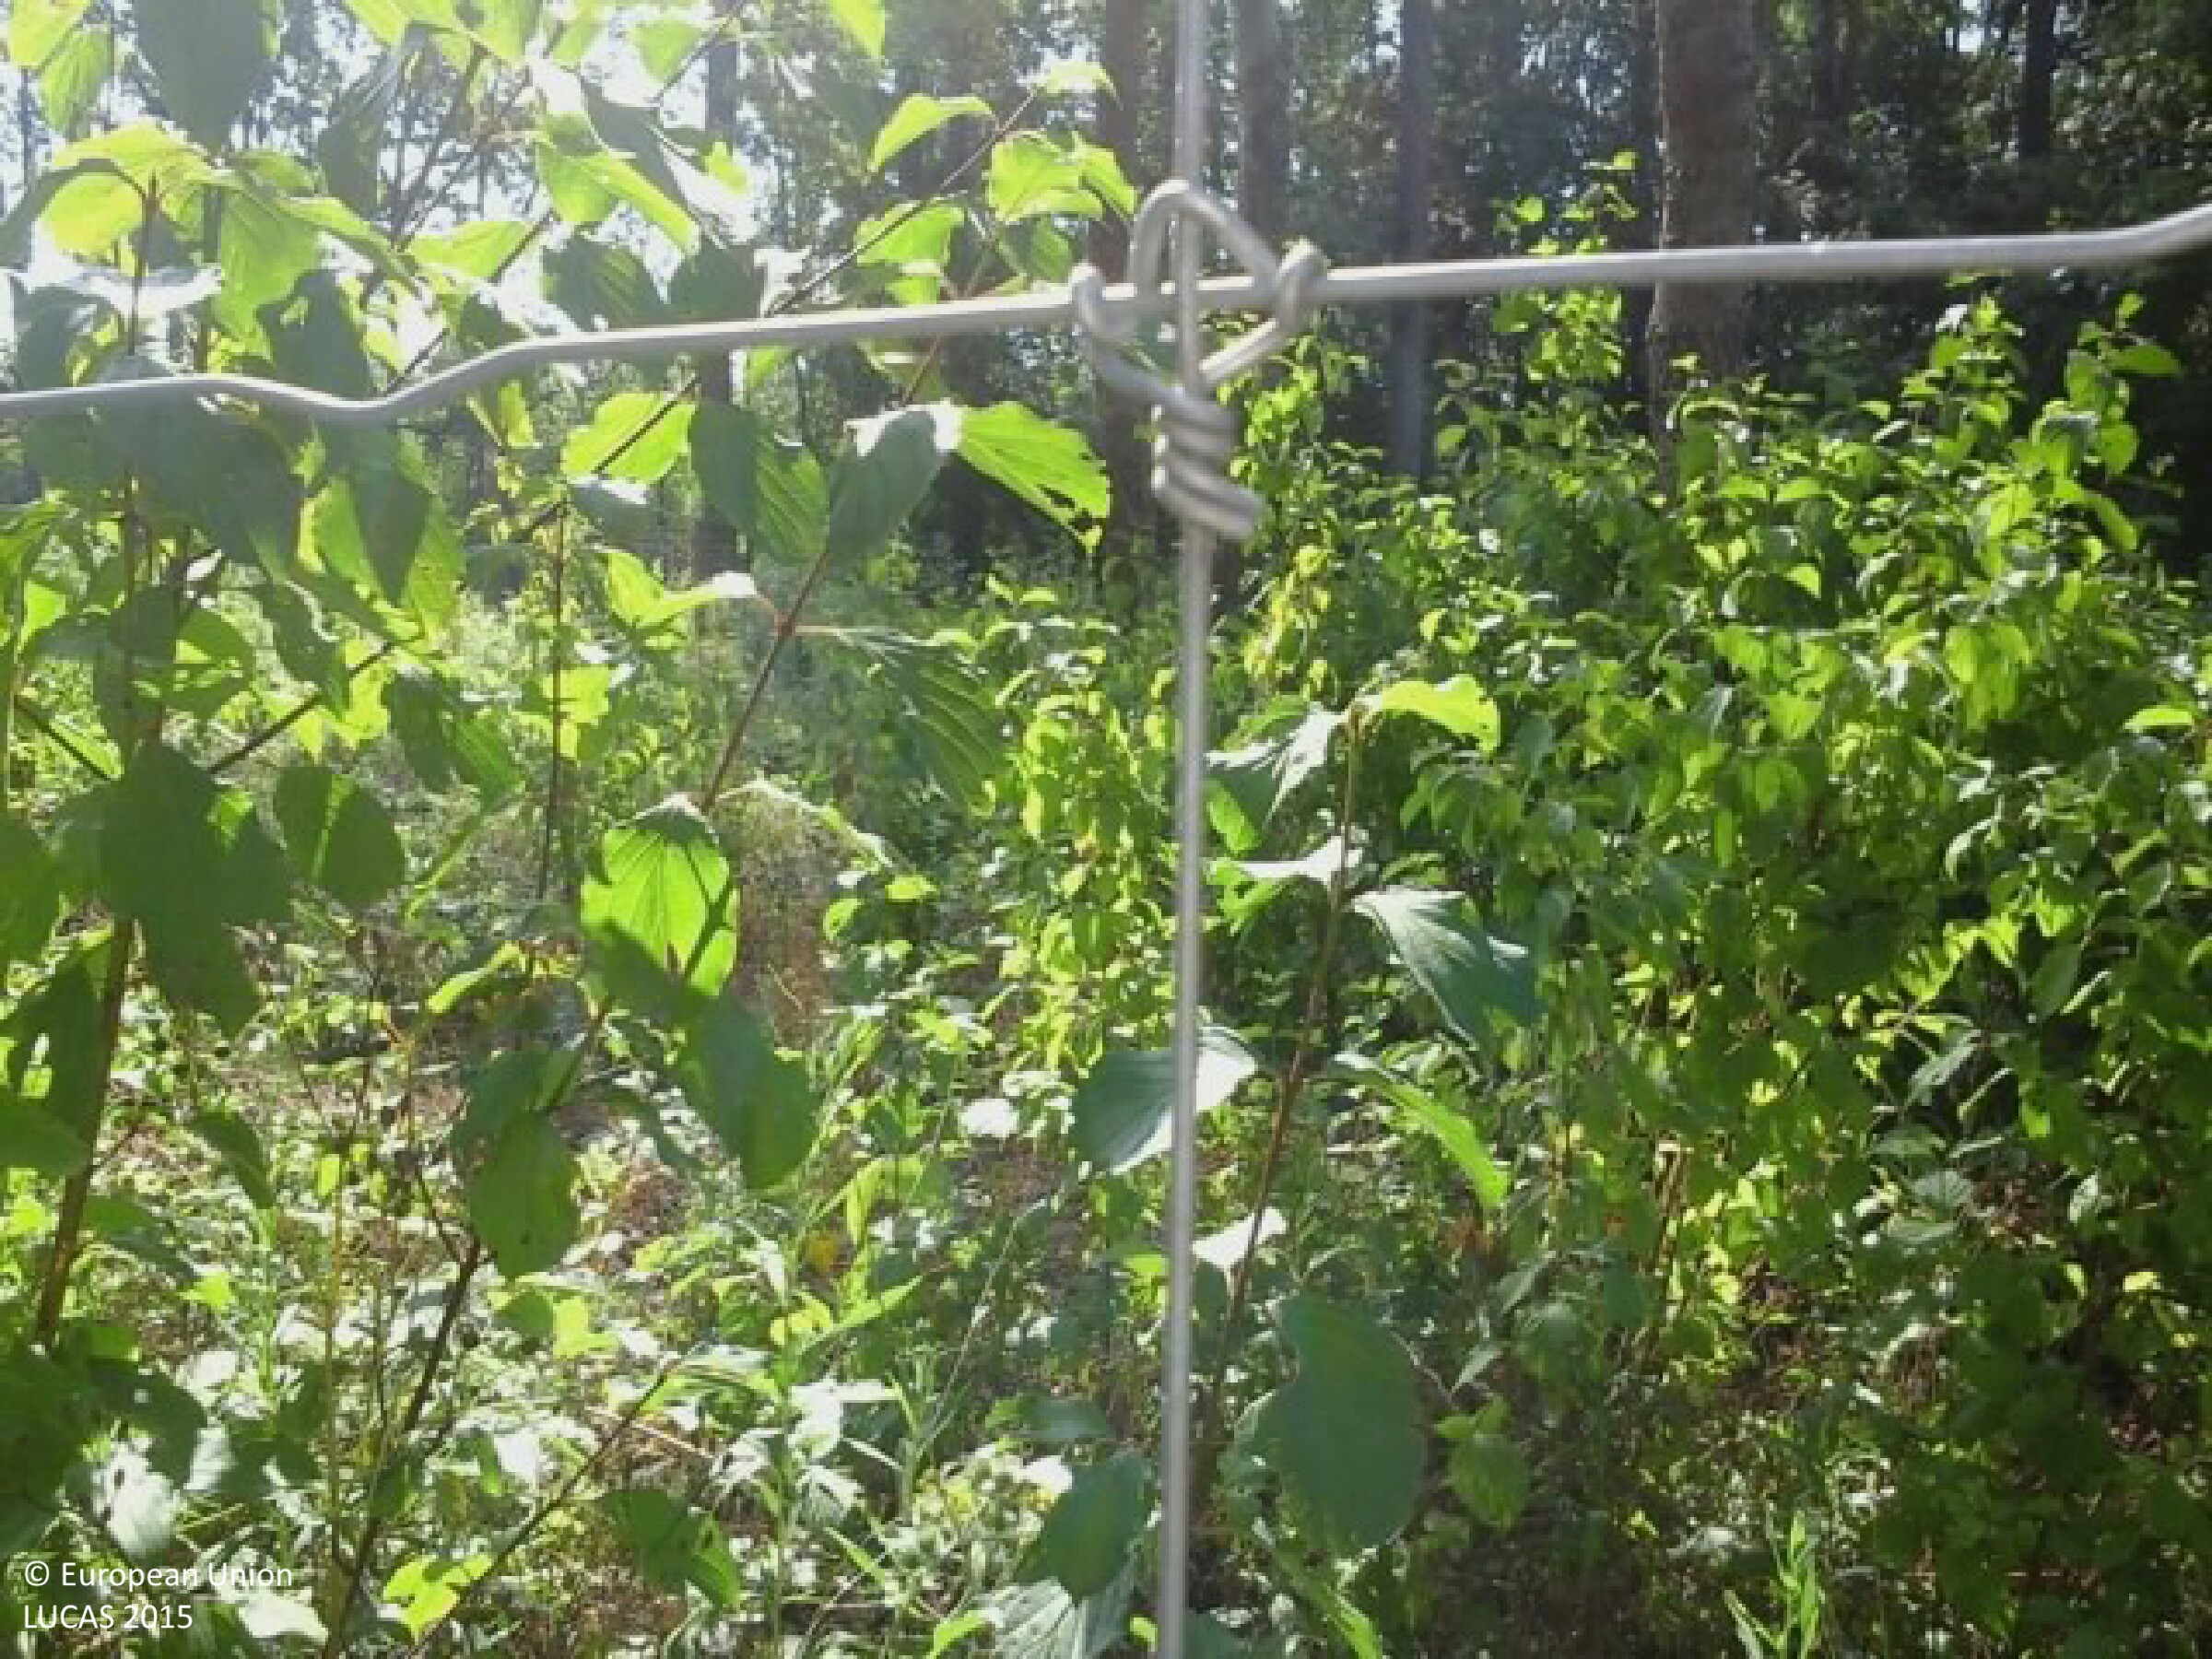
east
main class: Woodland
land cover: Broadleaved woodland
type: mesophytic deciduous forest
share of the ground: 25 - 50 %
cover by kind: broadleaved forest trees 60 %, herbaceous plants 25 %, shrubs 15 %
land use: Forestry
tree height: < 5 m
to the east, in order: Broadleaved woodland; Fences; Broadleaved woodland
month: July
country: HU
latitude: 46.3252
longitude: 18.8834
